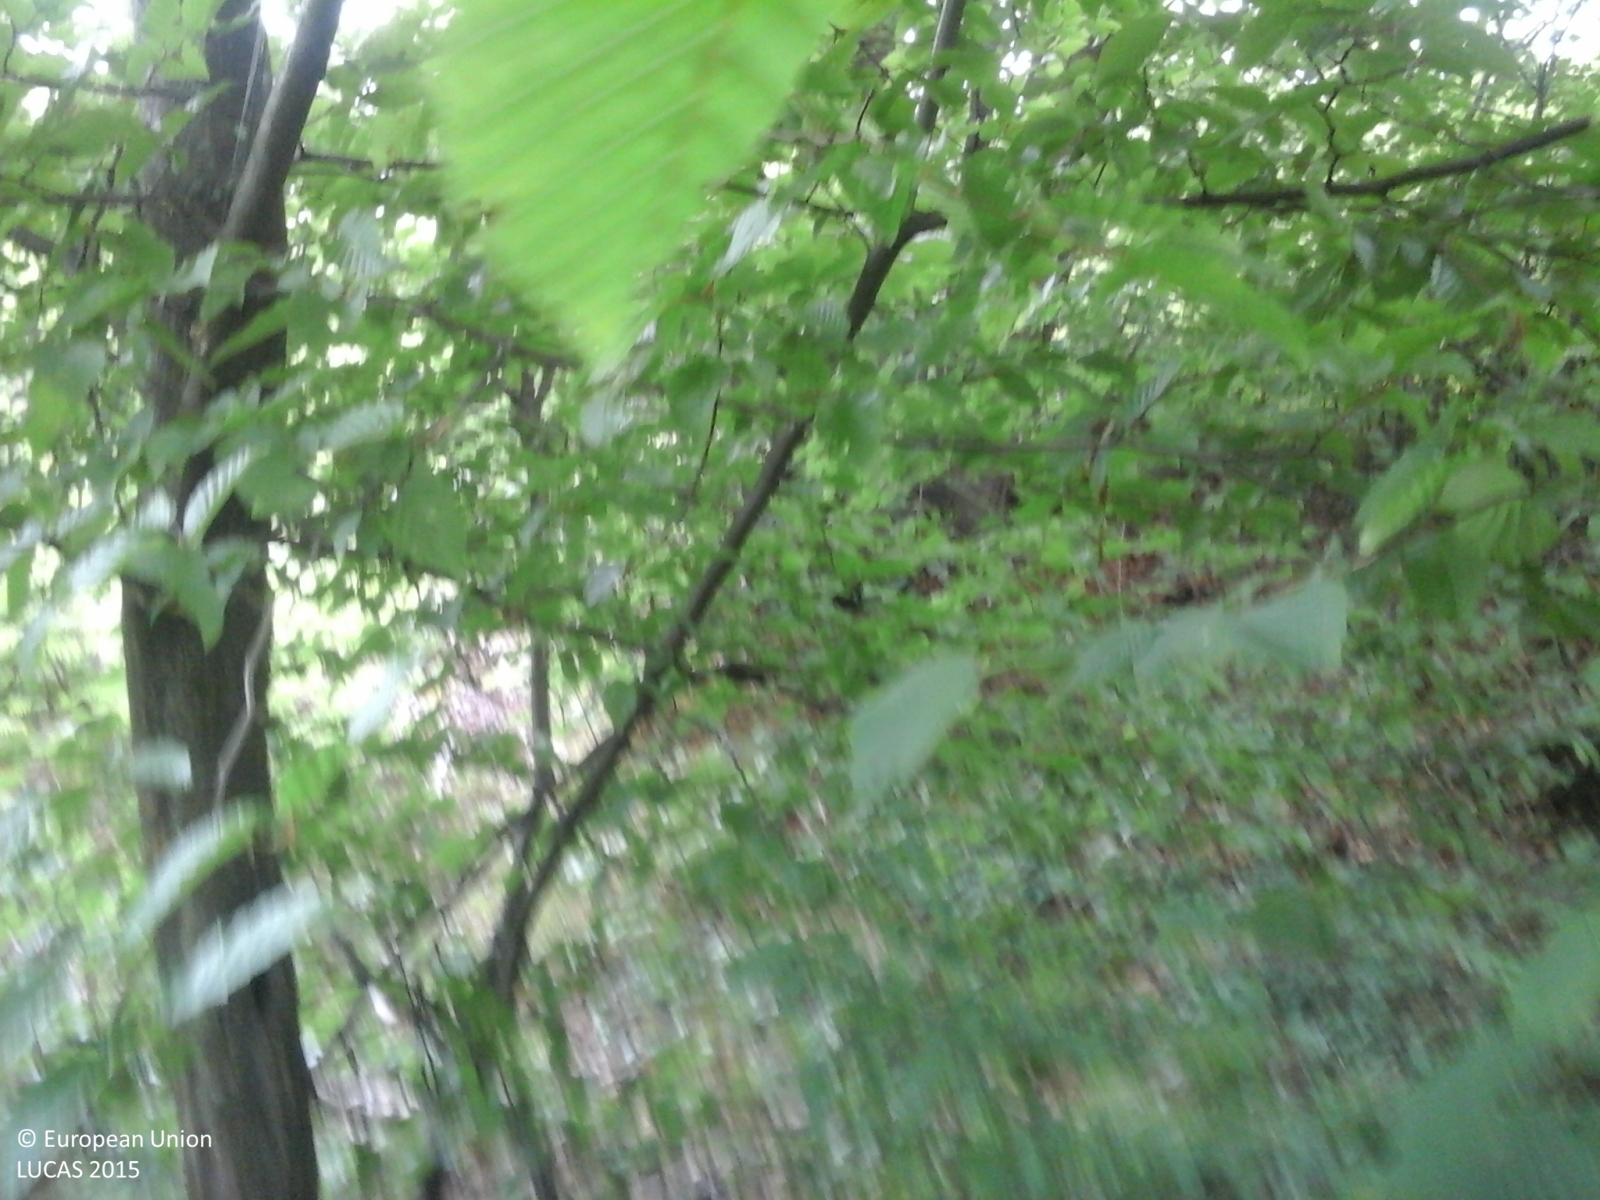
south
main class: Woodland
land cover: Broadleaved woodland
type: mesophytic deciduous forest
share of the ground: > 75 %
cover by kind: broadleaved forest trees 60 %, shrubs 40 %
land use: Forestry
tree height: > 5 m
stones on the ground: < 10 %
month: May
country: IT
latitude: 45.8424
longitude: 10.9642
